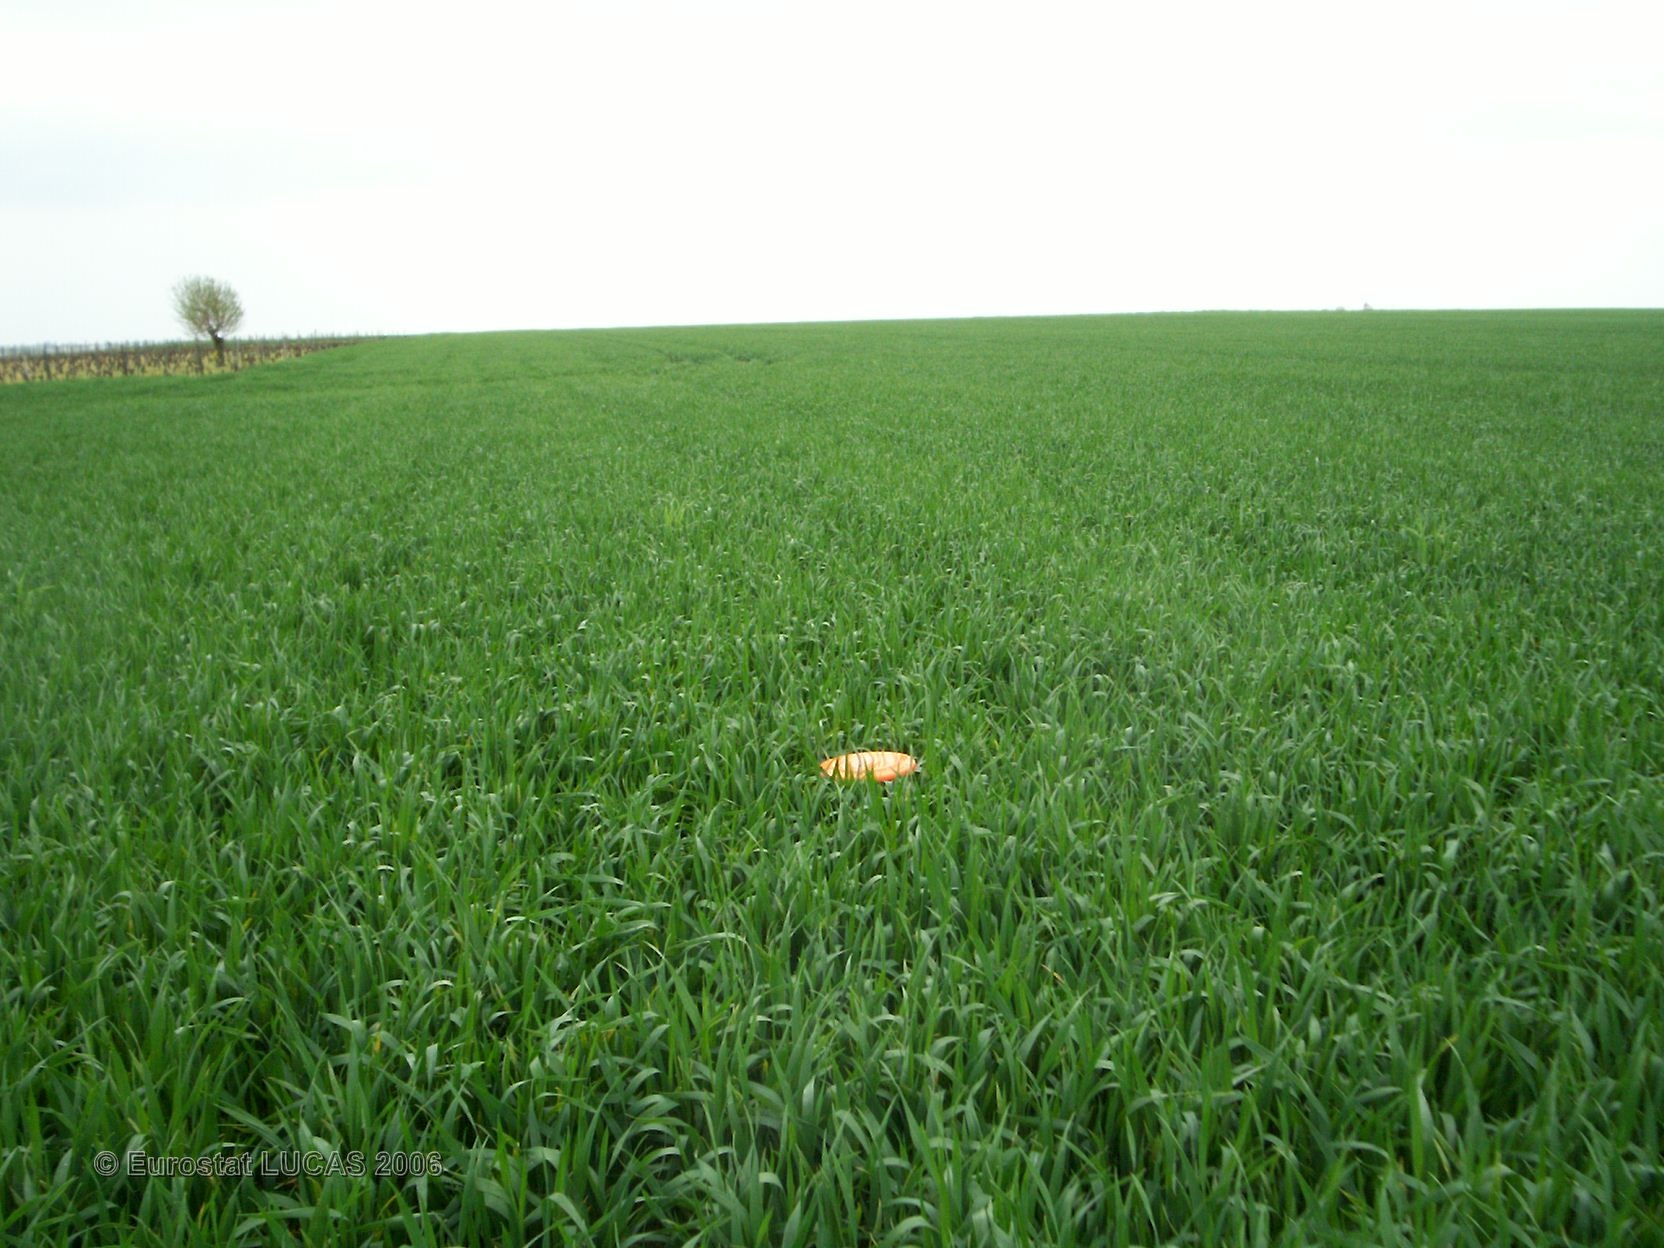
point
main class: Cropland
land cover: Common wheat
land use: Agriculture (excluding fallow land and kitchen gardens)
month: April
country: FR
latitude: 47.1055
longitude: 0.2932
